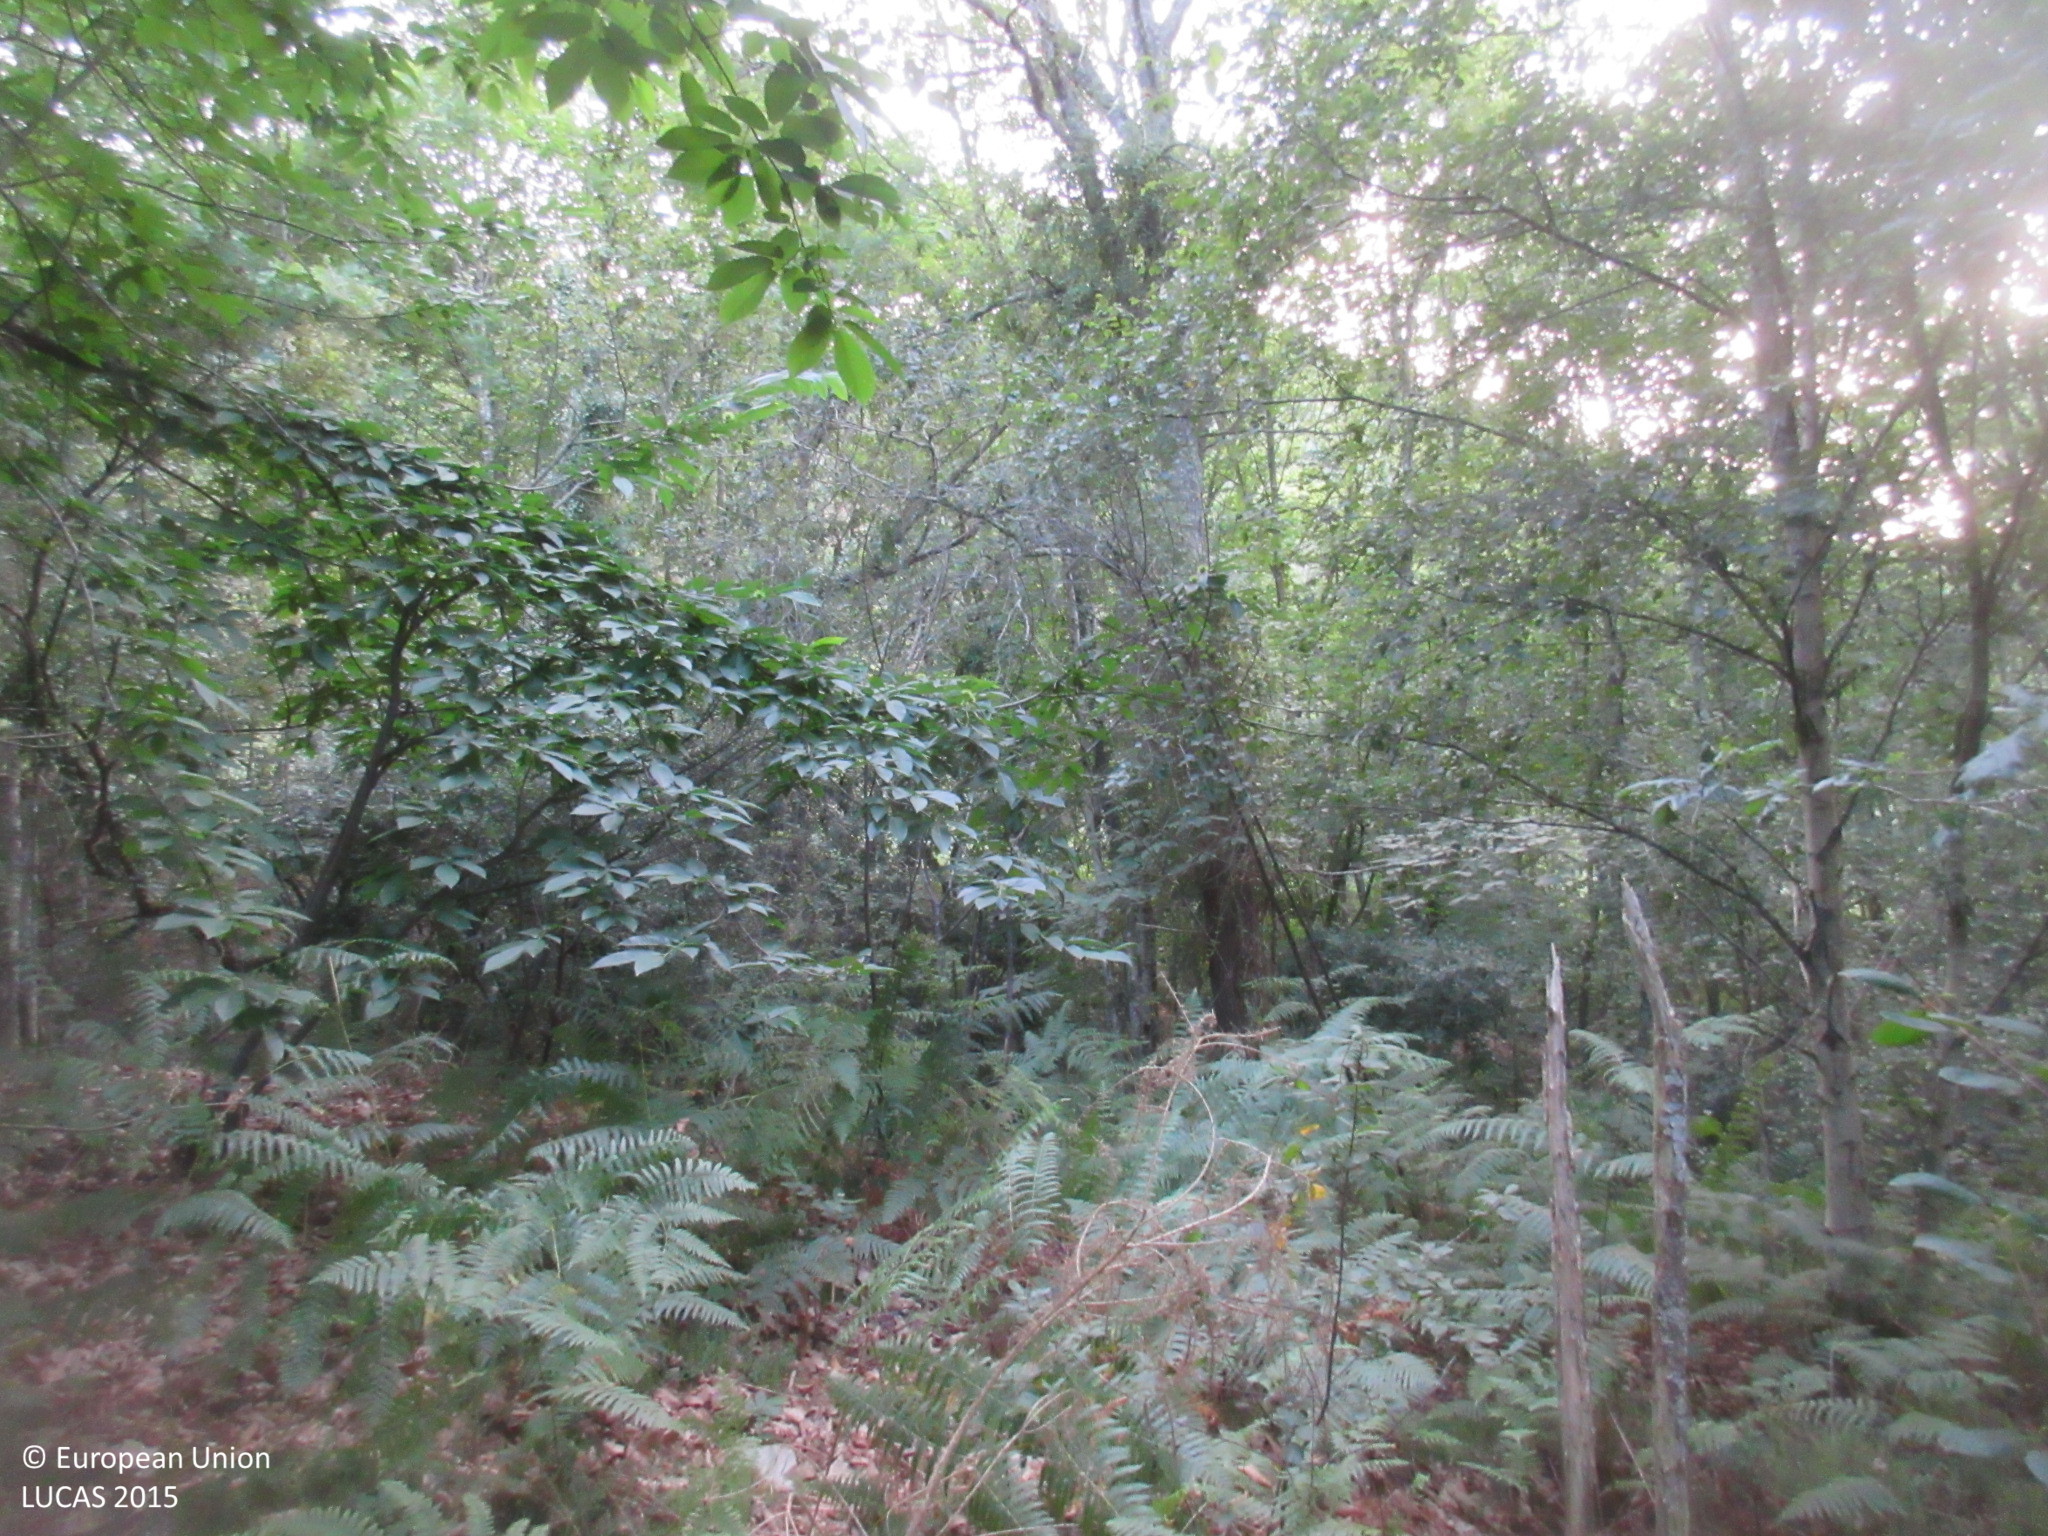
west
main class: Woodland
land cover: Broadleaved woodland
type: thermophilous deciduous forest
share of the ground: > 75 %
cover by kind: broadleaved forest trees 100 %
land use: Forestry
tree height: > 5 m
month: July
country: ES
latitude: 43.3994
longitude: -5.1236
